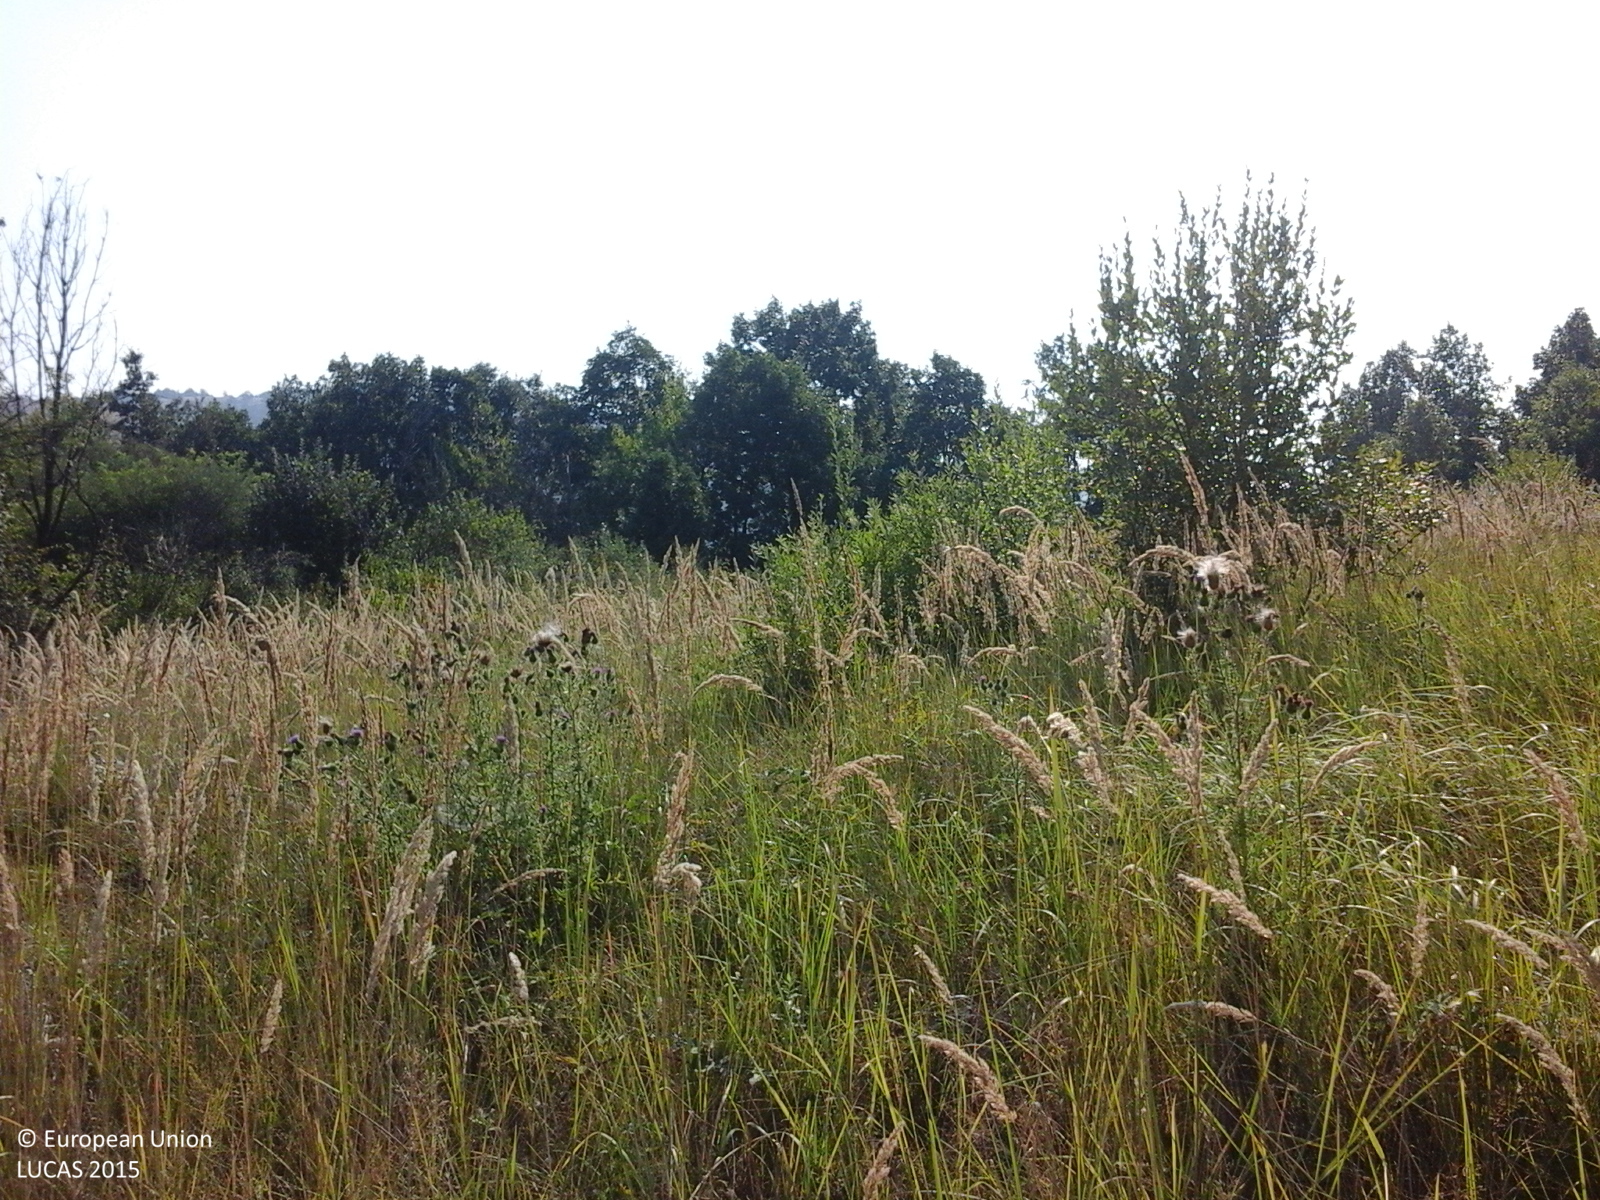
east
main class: Grassland
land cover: Spontaneously vegetated surfaces
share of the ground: > 75 %
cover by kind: herbaceous plants 100 %
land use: Semi-natural and natural areas not in use
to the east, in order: Spontaneously vegetated surfaces; Broadleaved woodland; Tracks; Broadleaved woodland; Grassland without tree/shrub cover; Tracks; Spontaneously vegetated surfaces; Grassland with sparse tree/shrub cover
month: August
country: RO
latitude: 46.2802
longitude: 22.1011
